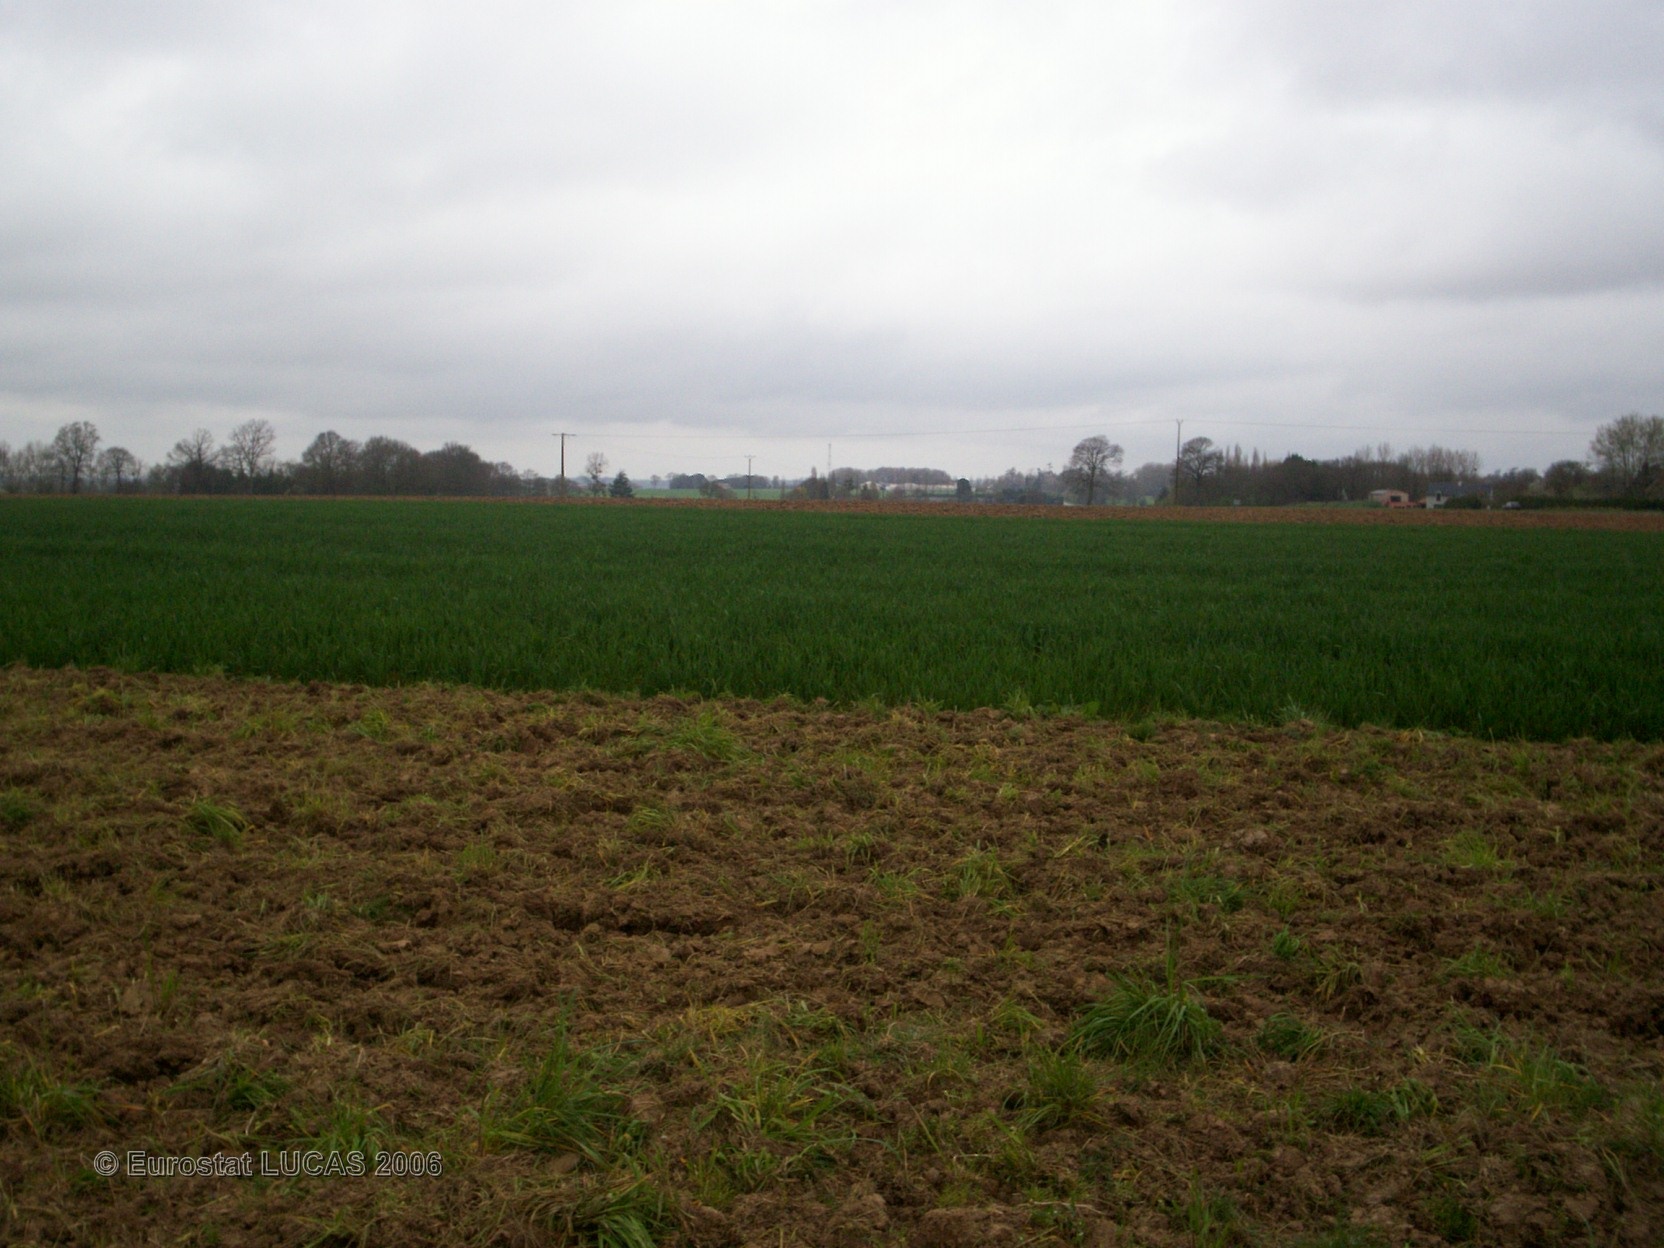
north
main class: Cropland
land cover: Common wheat
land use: Agriculture (excluding fallow land and kitchen gardens)
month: June
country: FR
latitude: 48.4361
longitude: -2.5105
